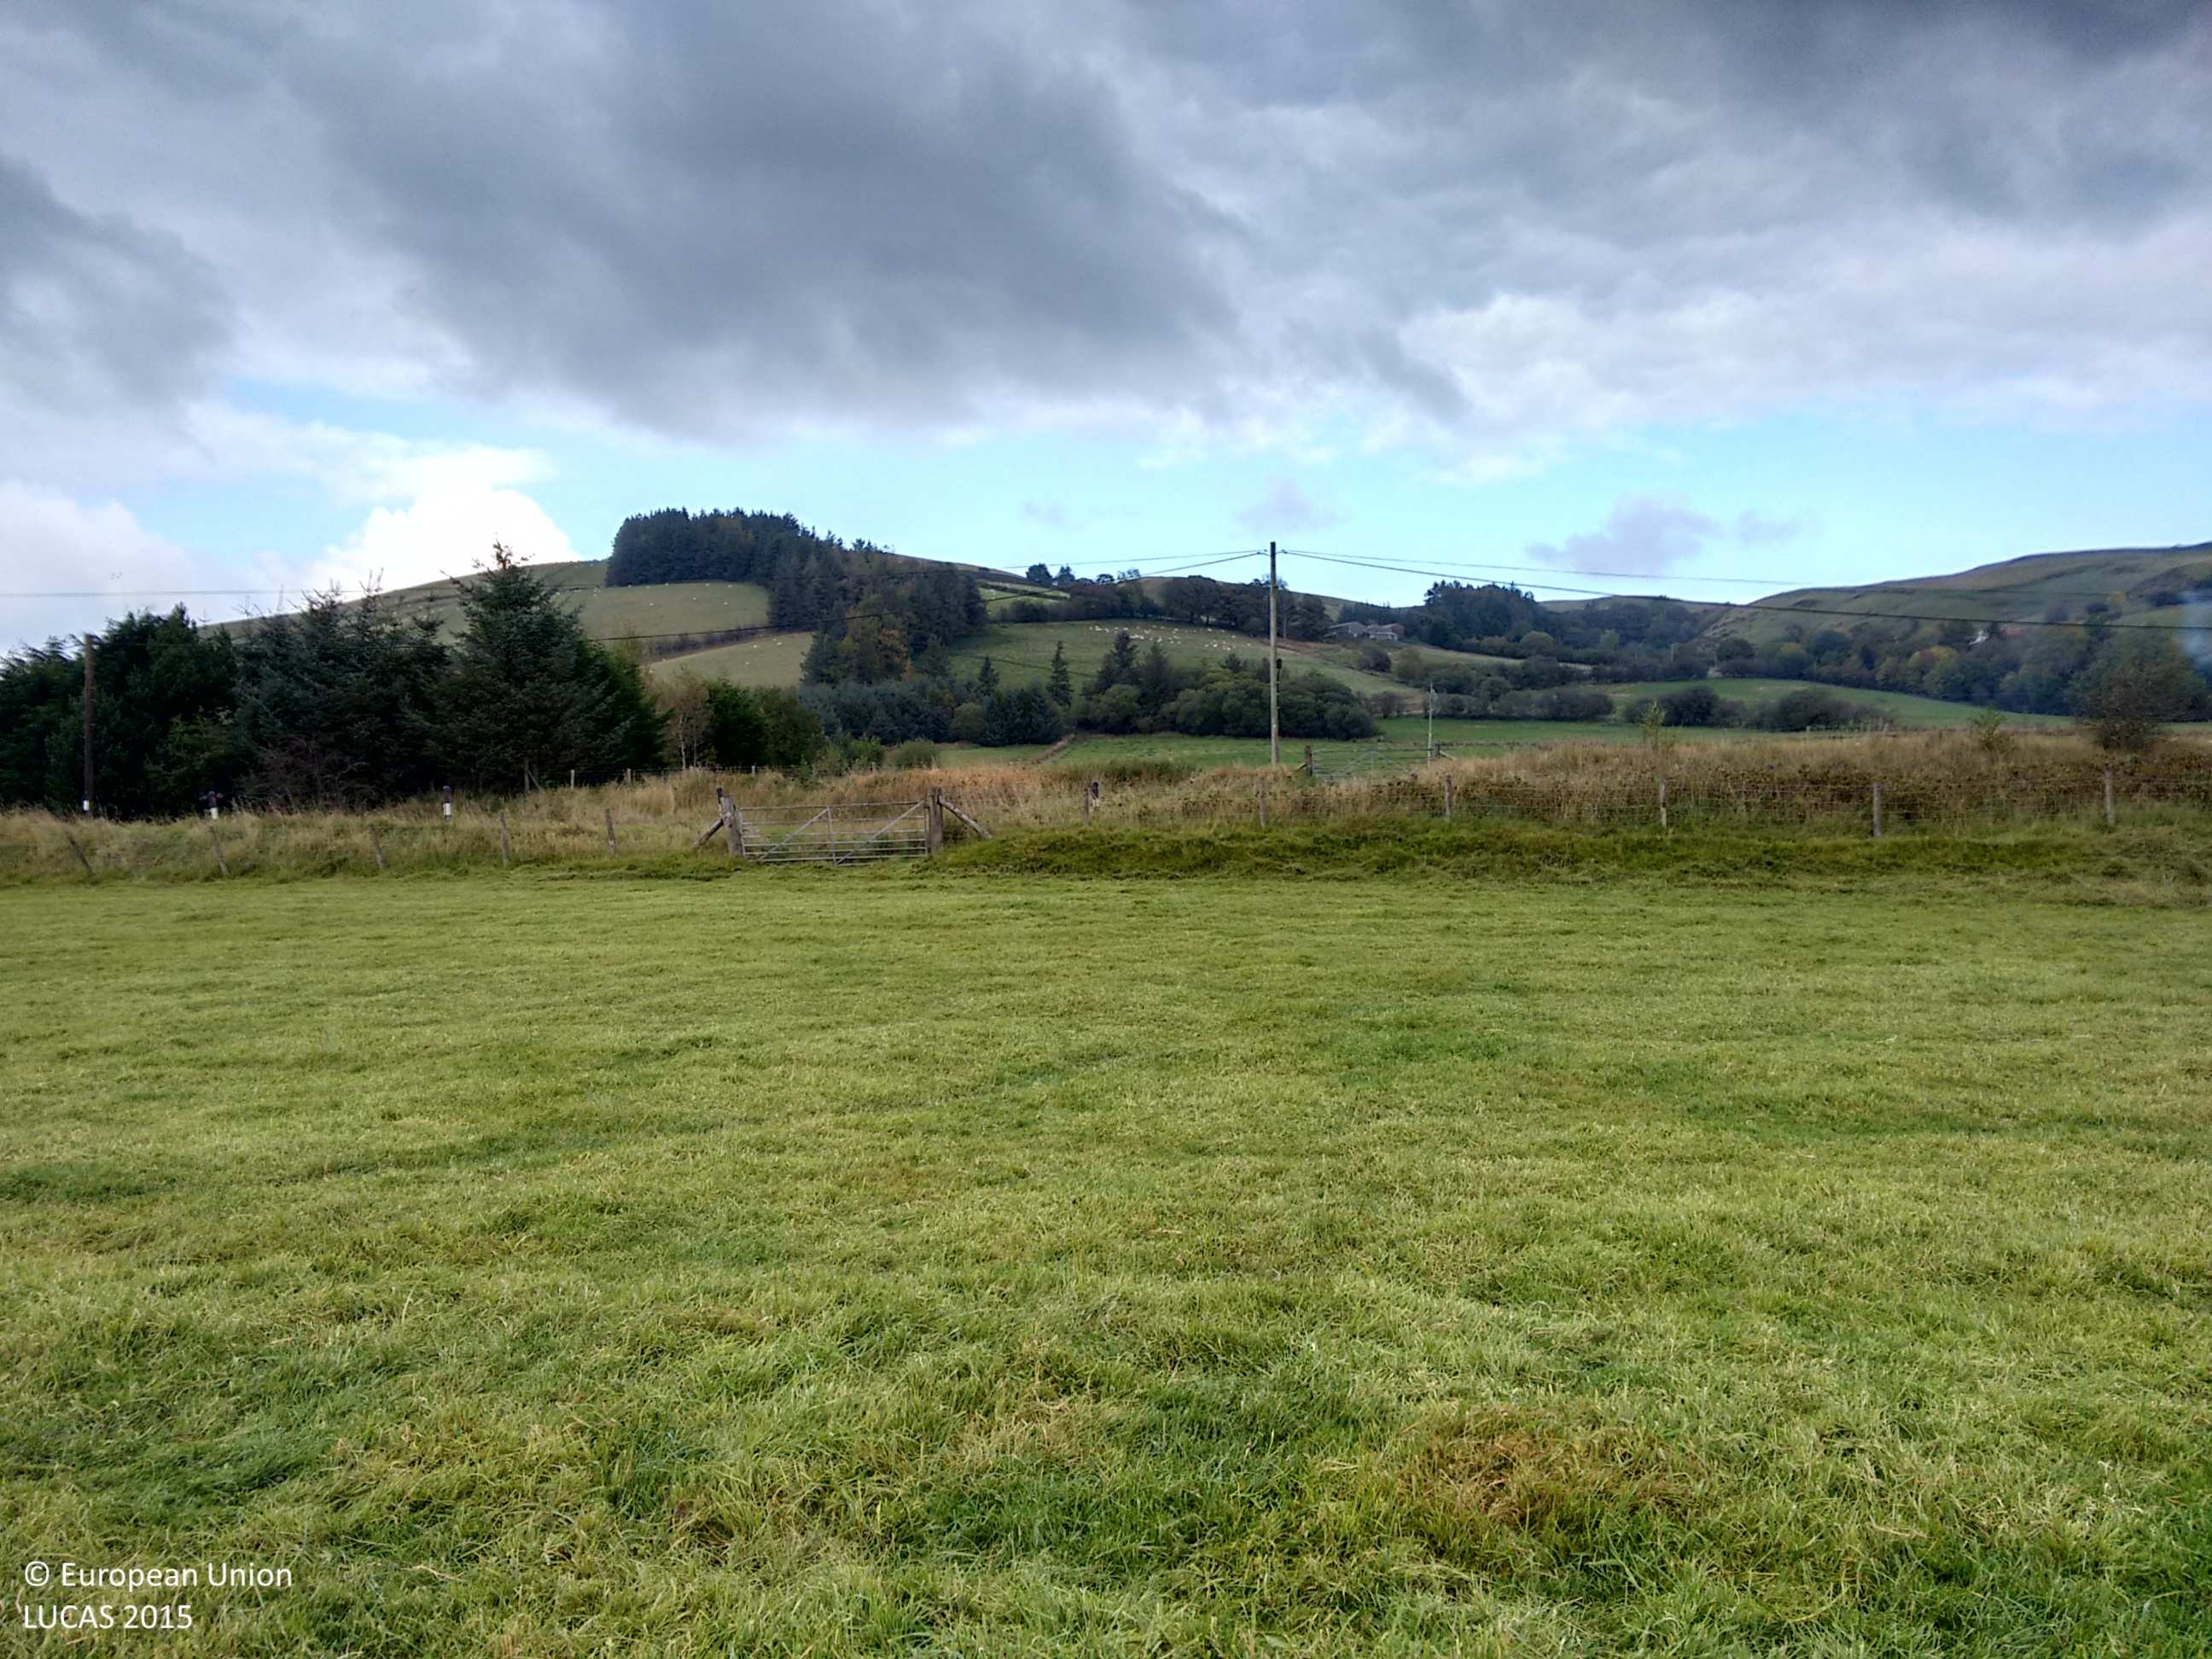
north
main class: Grassland
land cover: Grassland without tree/shrub cover
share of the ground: > 75 %
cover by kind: herbaceous plants 100 %
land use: Agriculture (excluding fallow land and kitchen gardens)
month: October
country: GB
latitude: 52.4080
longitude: -3.6256
